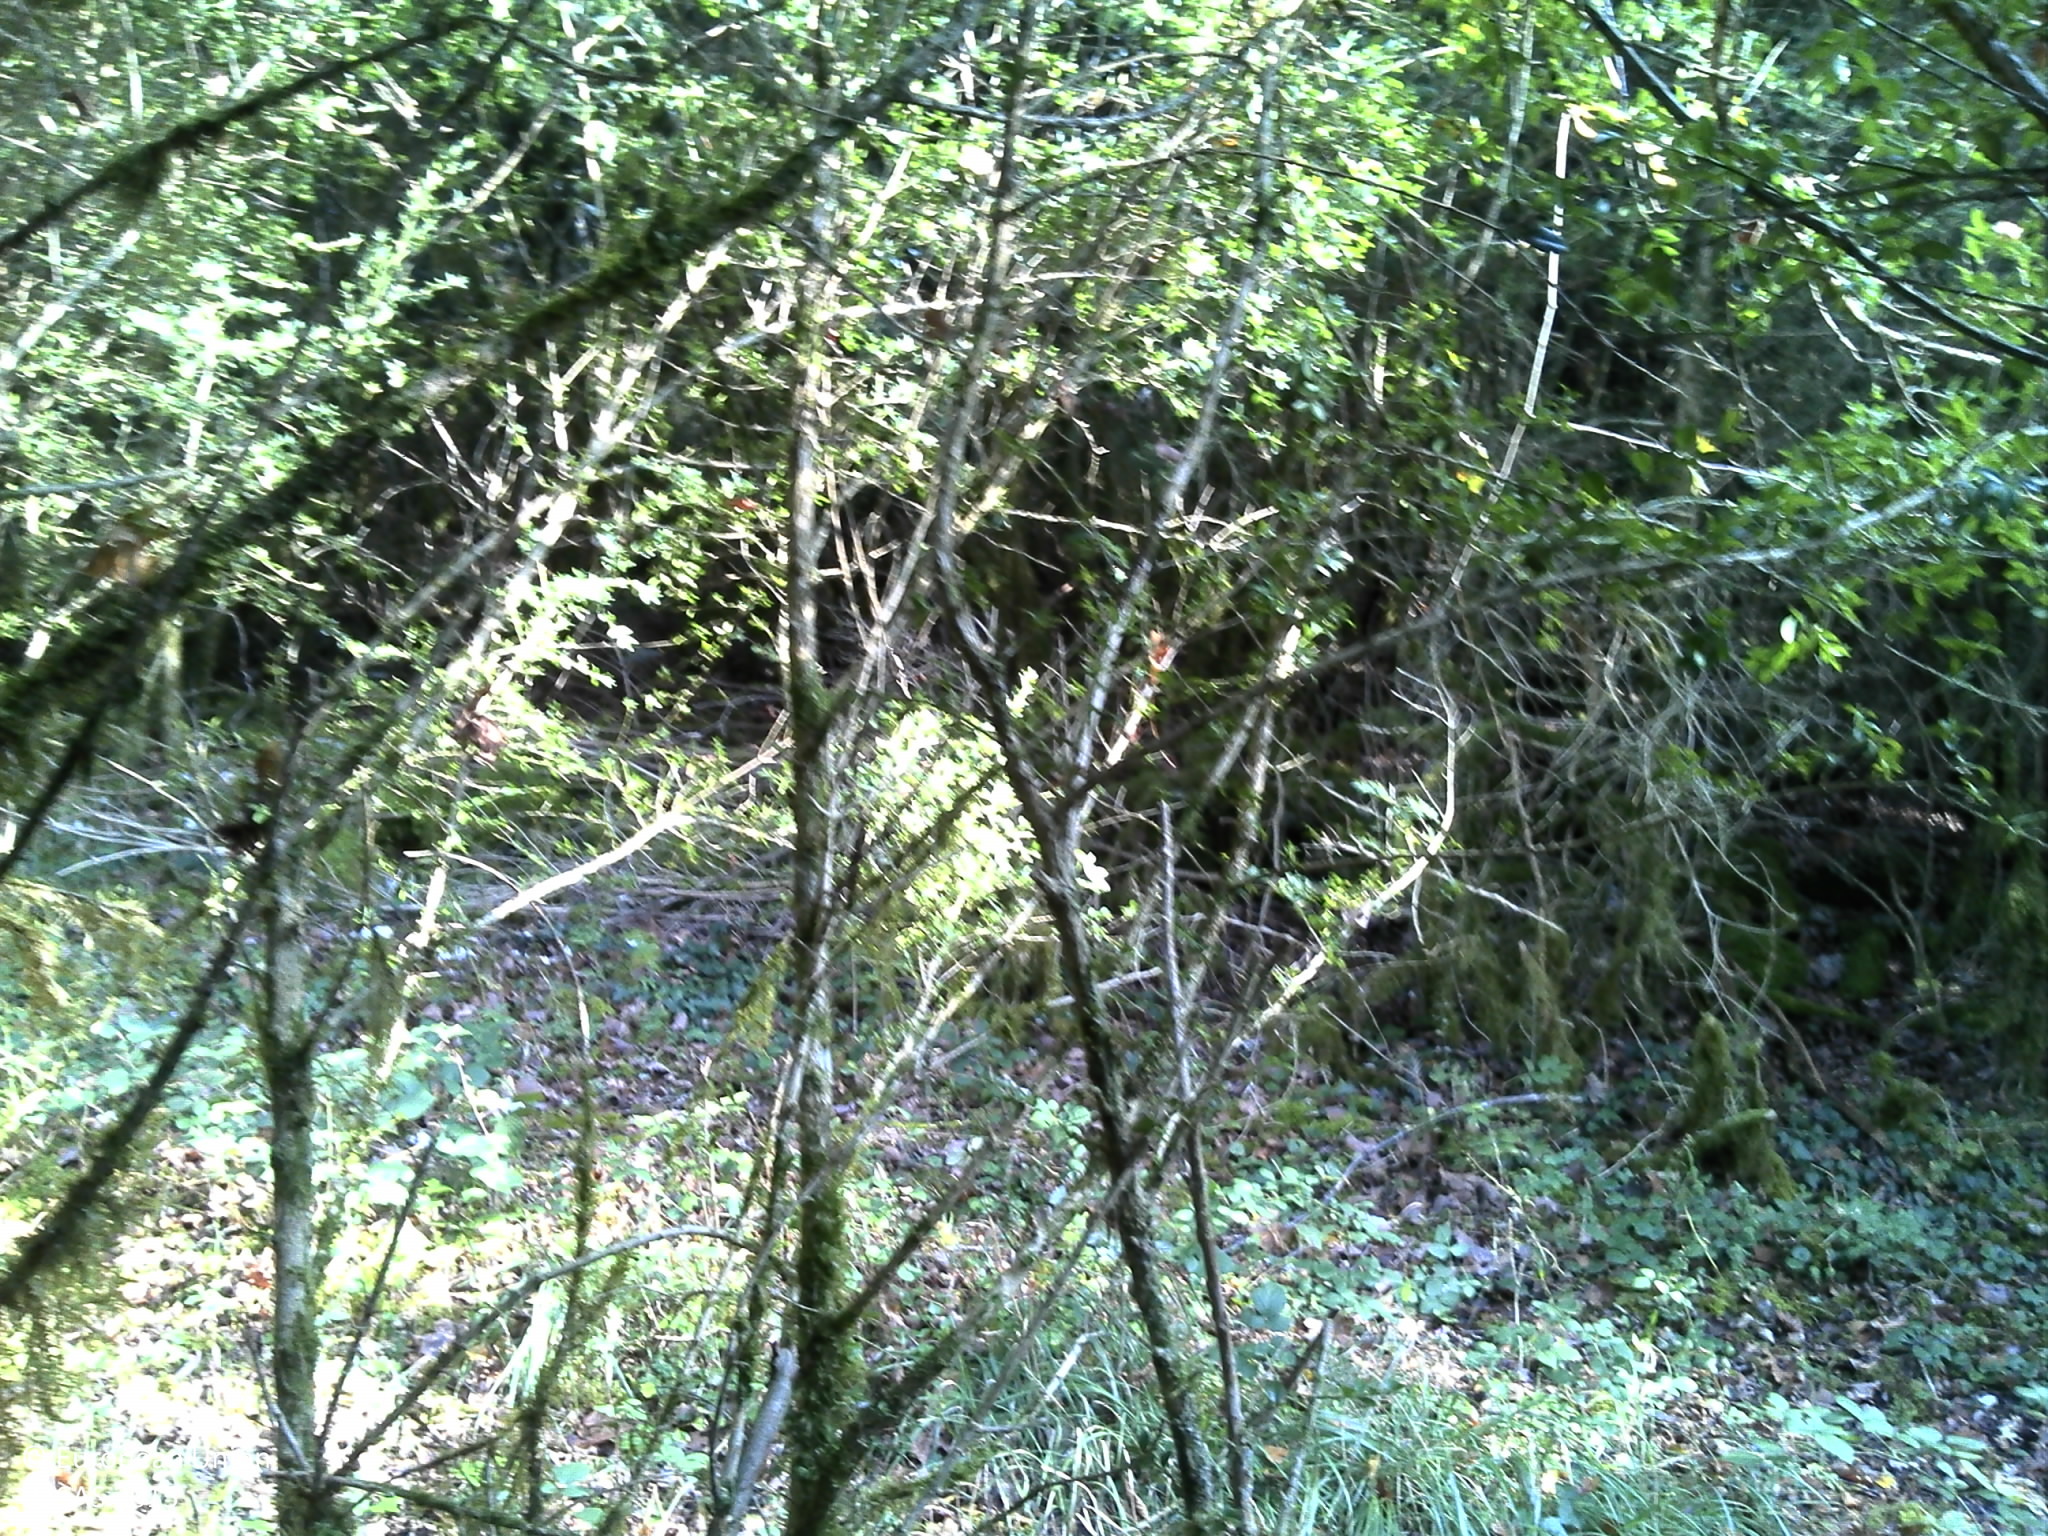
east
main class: Woodland
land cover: Broadleaved woodland
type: mesophytic deciduous forest
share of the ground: > 75 %
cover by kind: broadleaved forest trees 90 %, consolidated bare surface 5 %, unconsolidated bare surface 5 %
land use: Semi-natural and natural areas not in use
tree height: > 5 m
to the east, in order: Broadleaved woodland; Grass margins; Paved roads, cycling and walking lanes; Grass margins; Spruce dominated mixed woodland; Broadleaved woodland
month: October
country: FR
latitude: 46.1623
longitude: 5.4058
